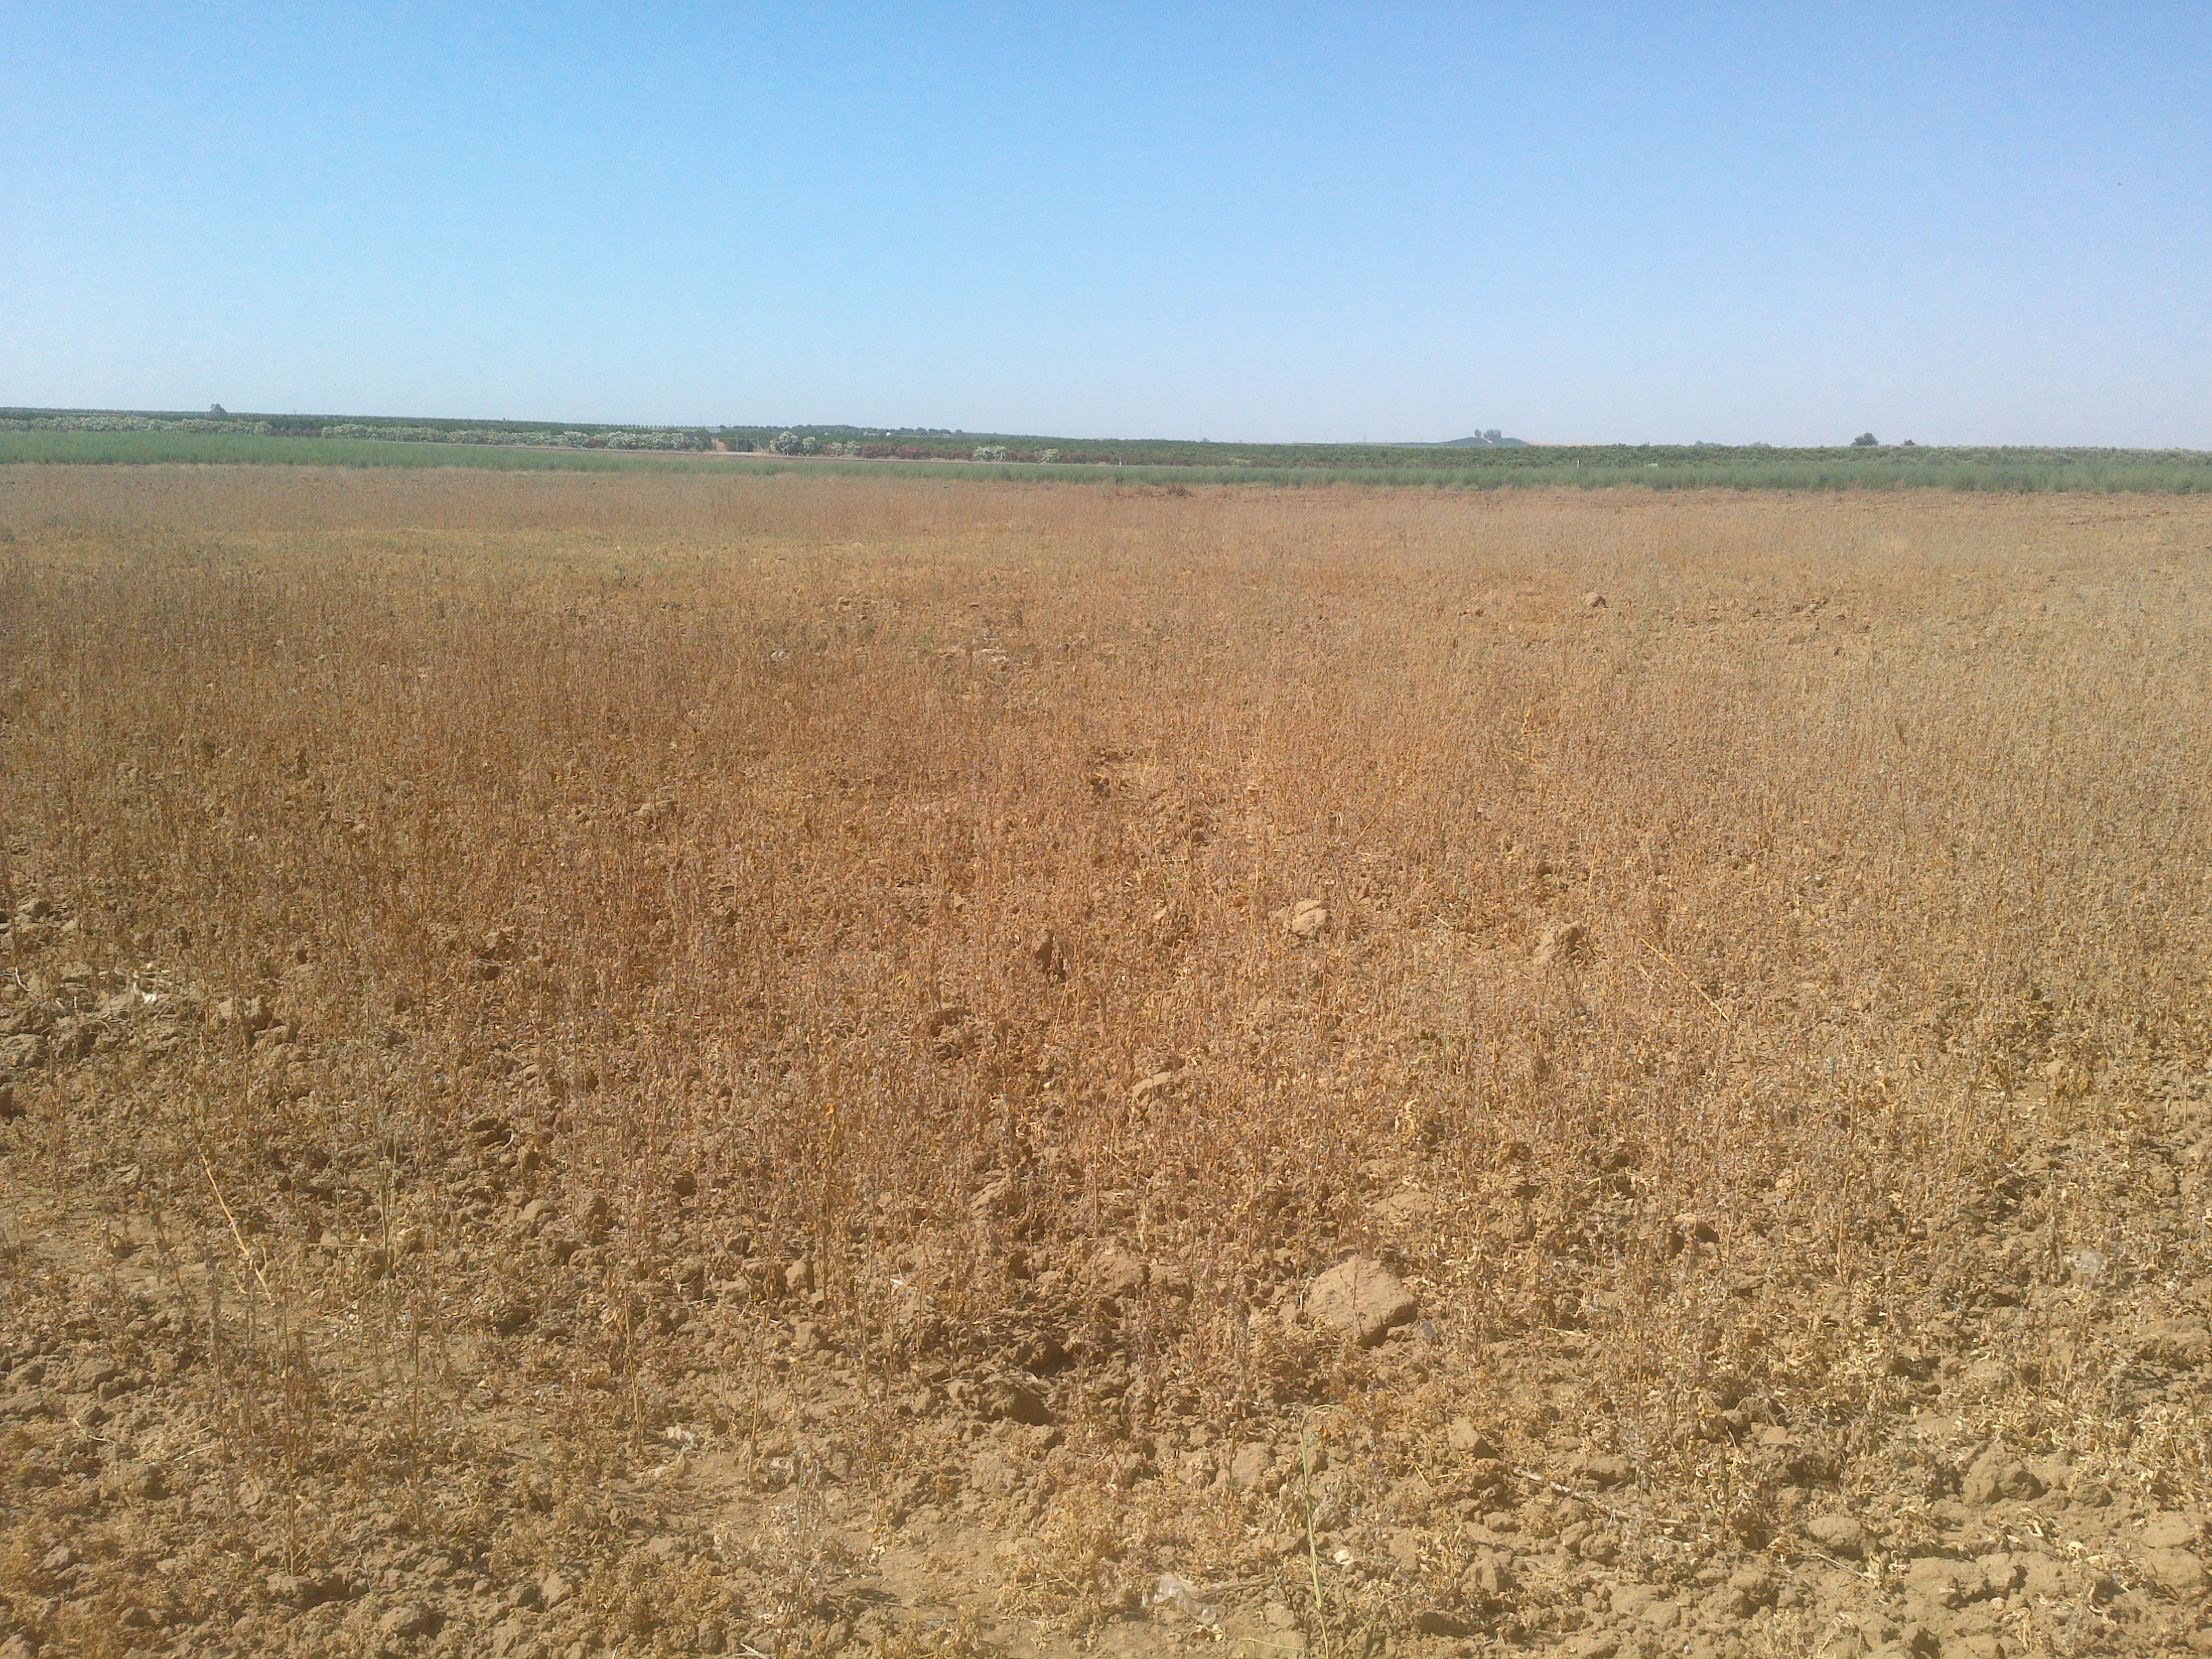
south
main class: Cropland
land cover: Olive groves
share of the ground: 50 - 75 %
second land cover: Spontaneously vegetated surfaces
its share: 10 - 25 %
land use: Agriculture (excluding fallow land and kitchen gardens)
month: June
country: ES
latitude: 37.7134
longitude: -5.2069
